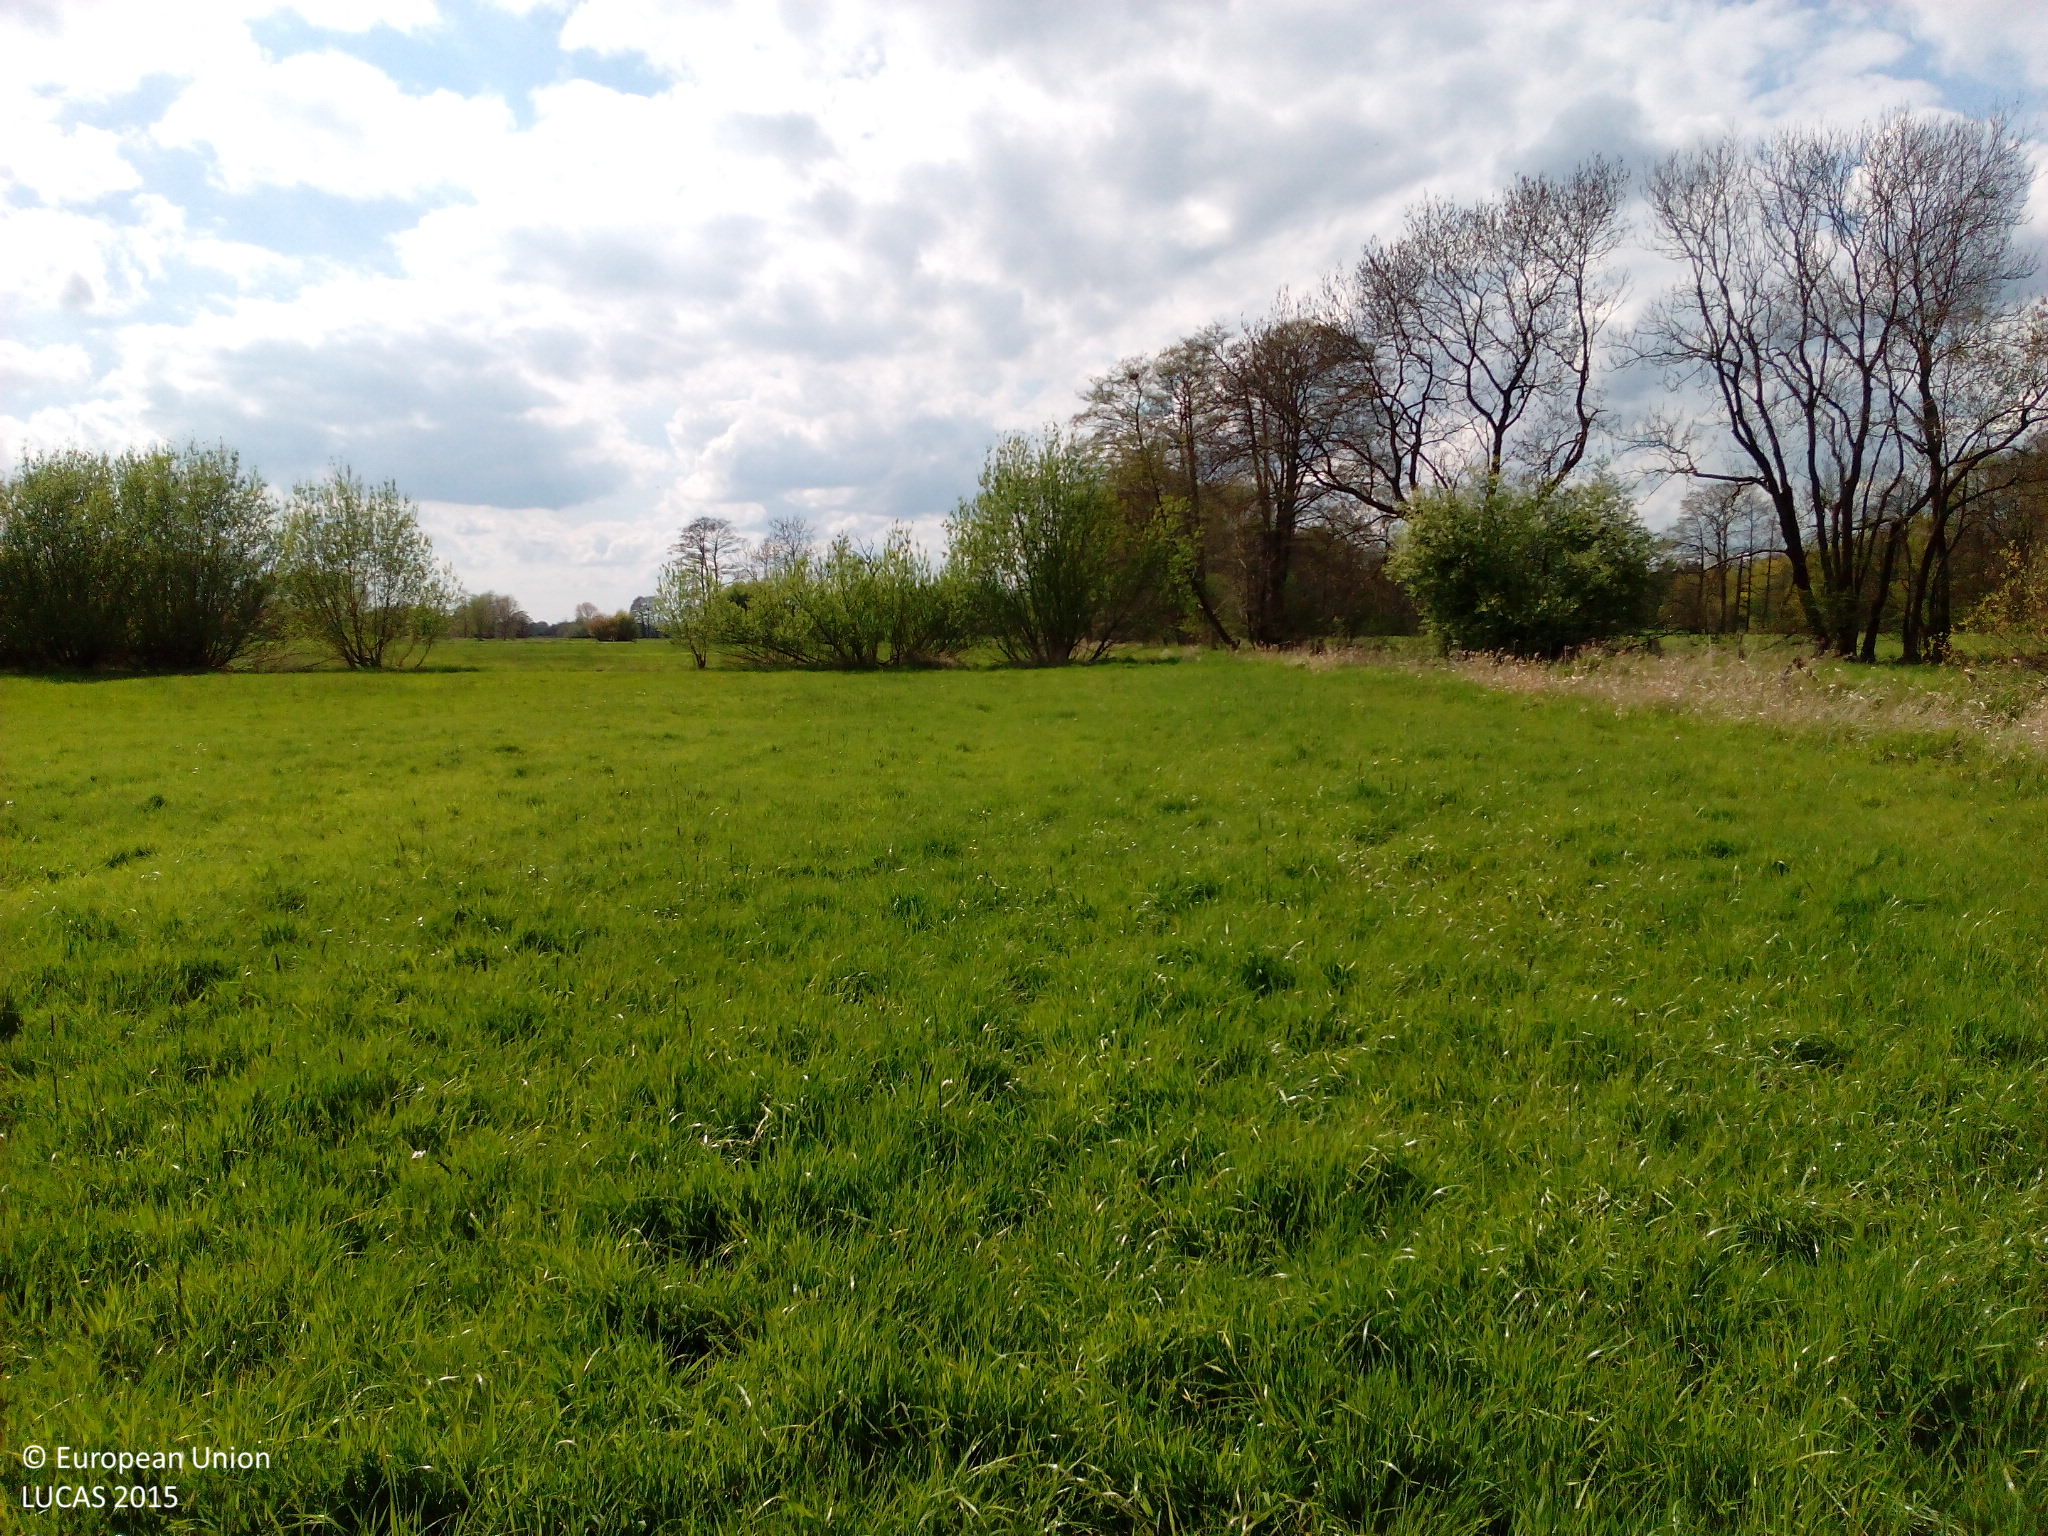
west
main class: Grassland
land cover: Grassland without tree/shrub cover
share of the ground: > 75 %
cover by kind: herbaceous plants 100 %
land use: Agriculture (excluding fallow land and kitchen gardens)
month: May
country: DE
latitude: 53.1109
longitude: 9.0891
